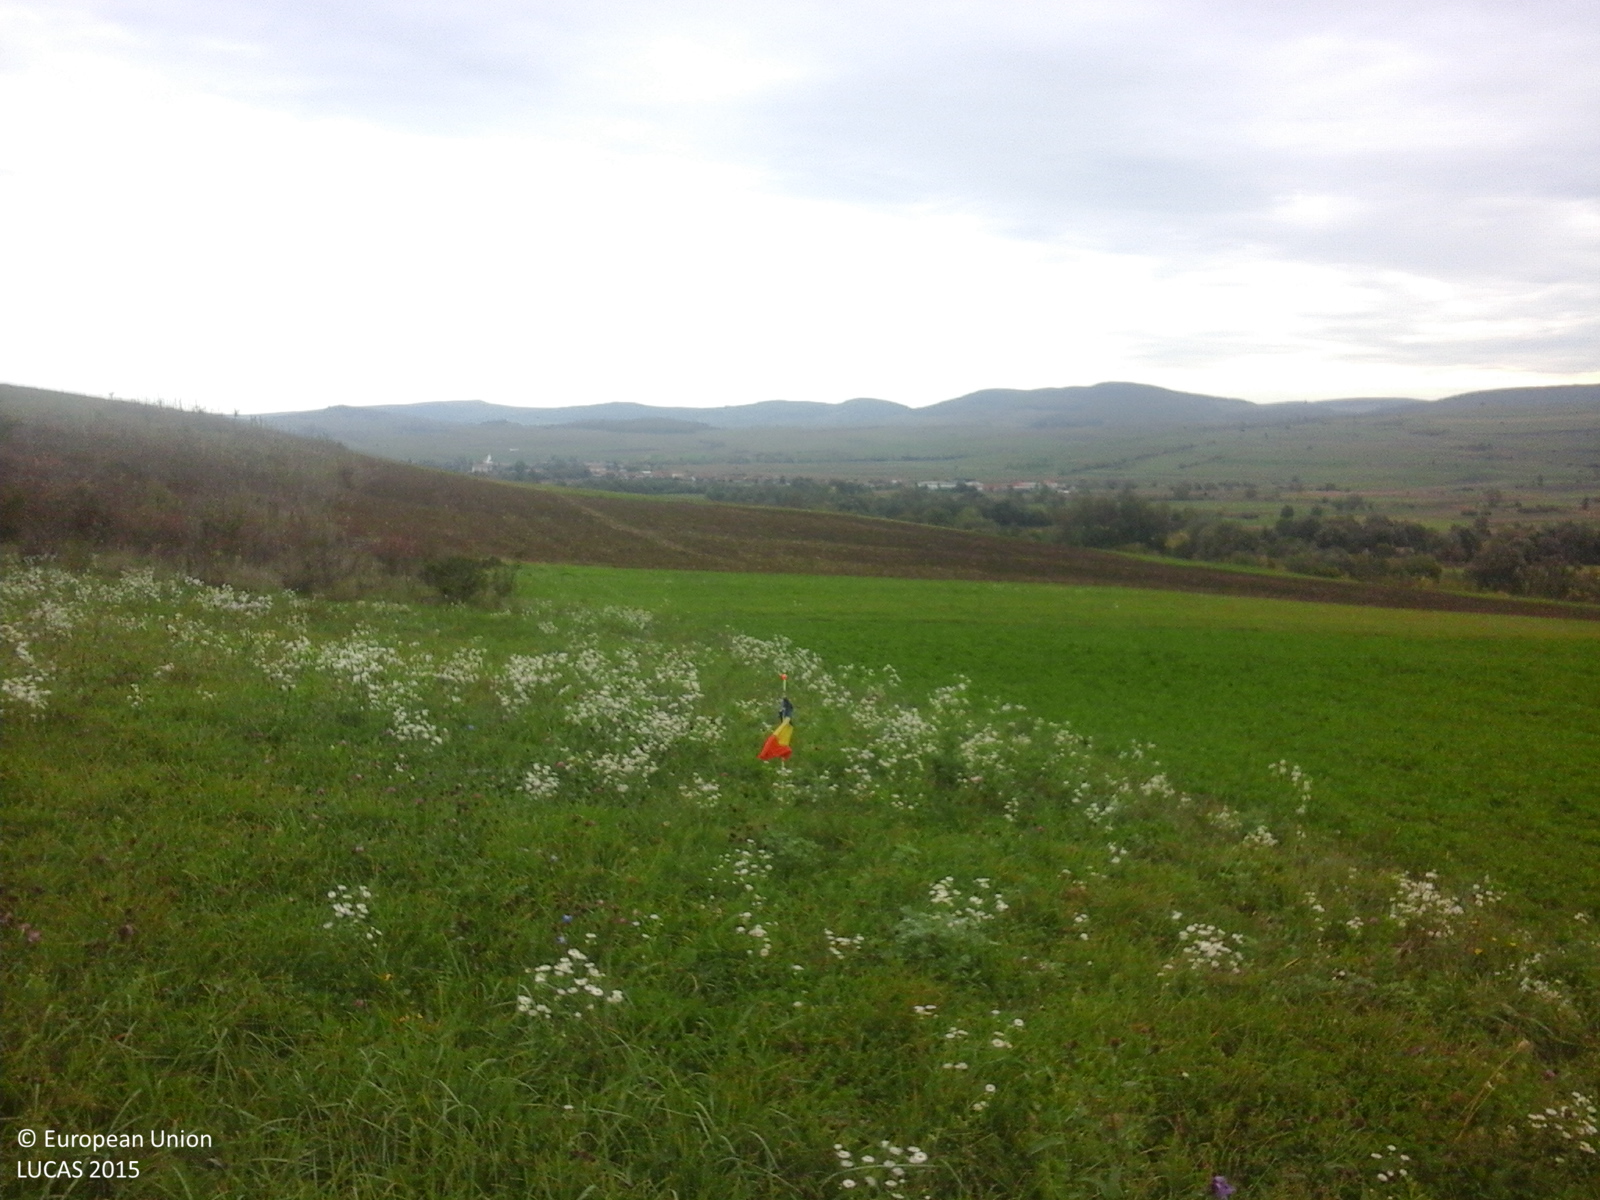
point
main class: Grassland
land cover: Grassland without tree/shrub cover
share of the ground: > 75 %
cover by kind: herbaceous plants 100 %
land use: Agriculture (excluding fallow land and kitchen gardens)
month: October
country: RO
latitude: 46.2658
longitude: 25.1895
